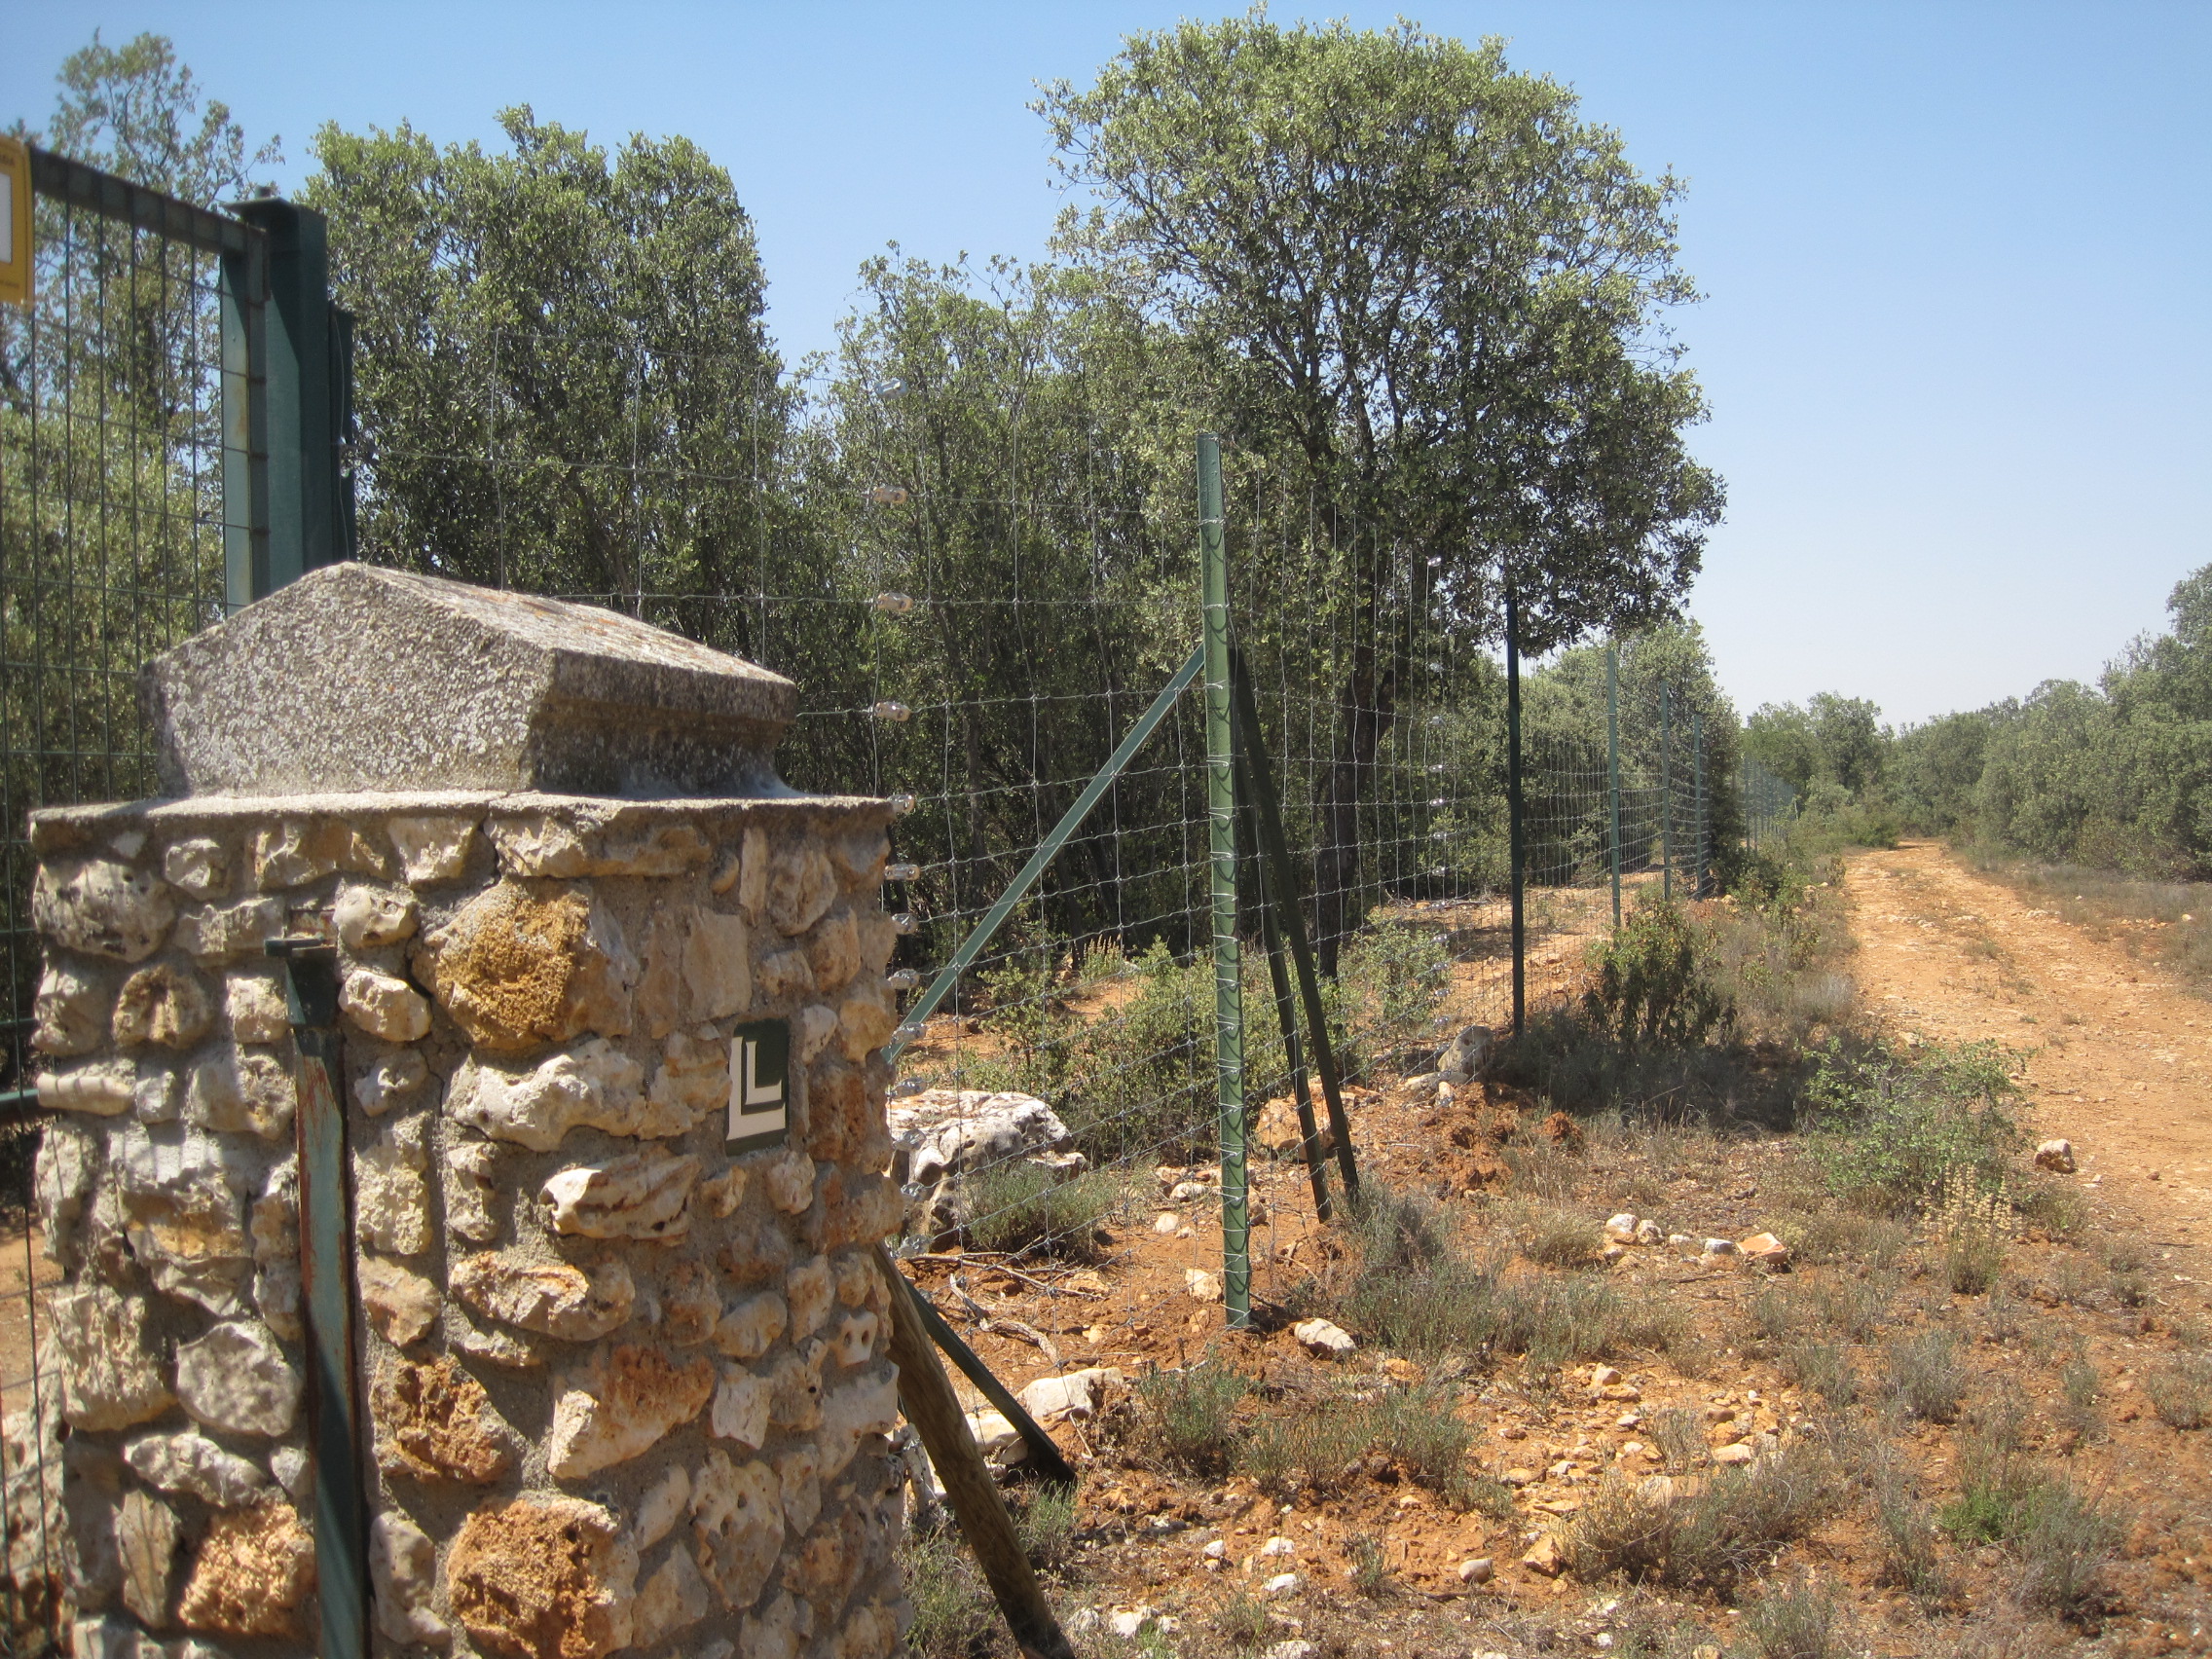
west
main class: Woodland
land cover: Broadleaved woodland
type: thermophilous deciduous forest
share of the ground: > 75 %
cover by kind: broadleaved forest trees 80 %, herbaceous plants 20 %
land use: Forestry
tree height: > 5 m
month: July
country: ES
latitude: 41.7460
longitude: -5.1454
